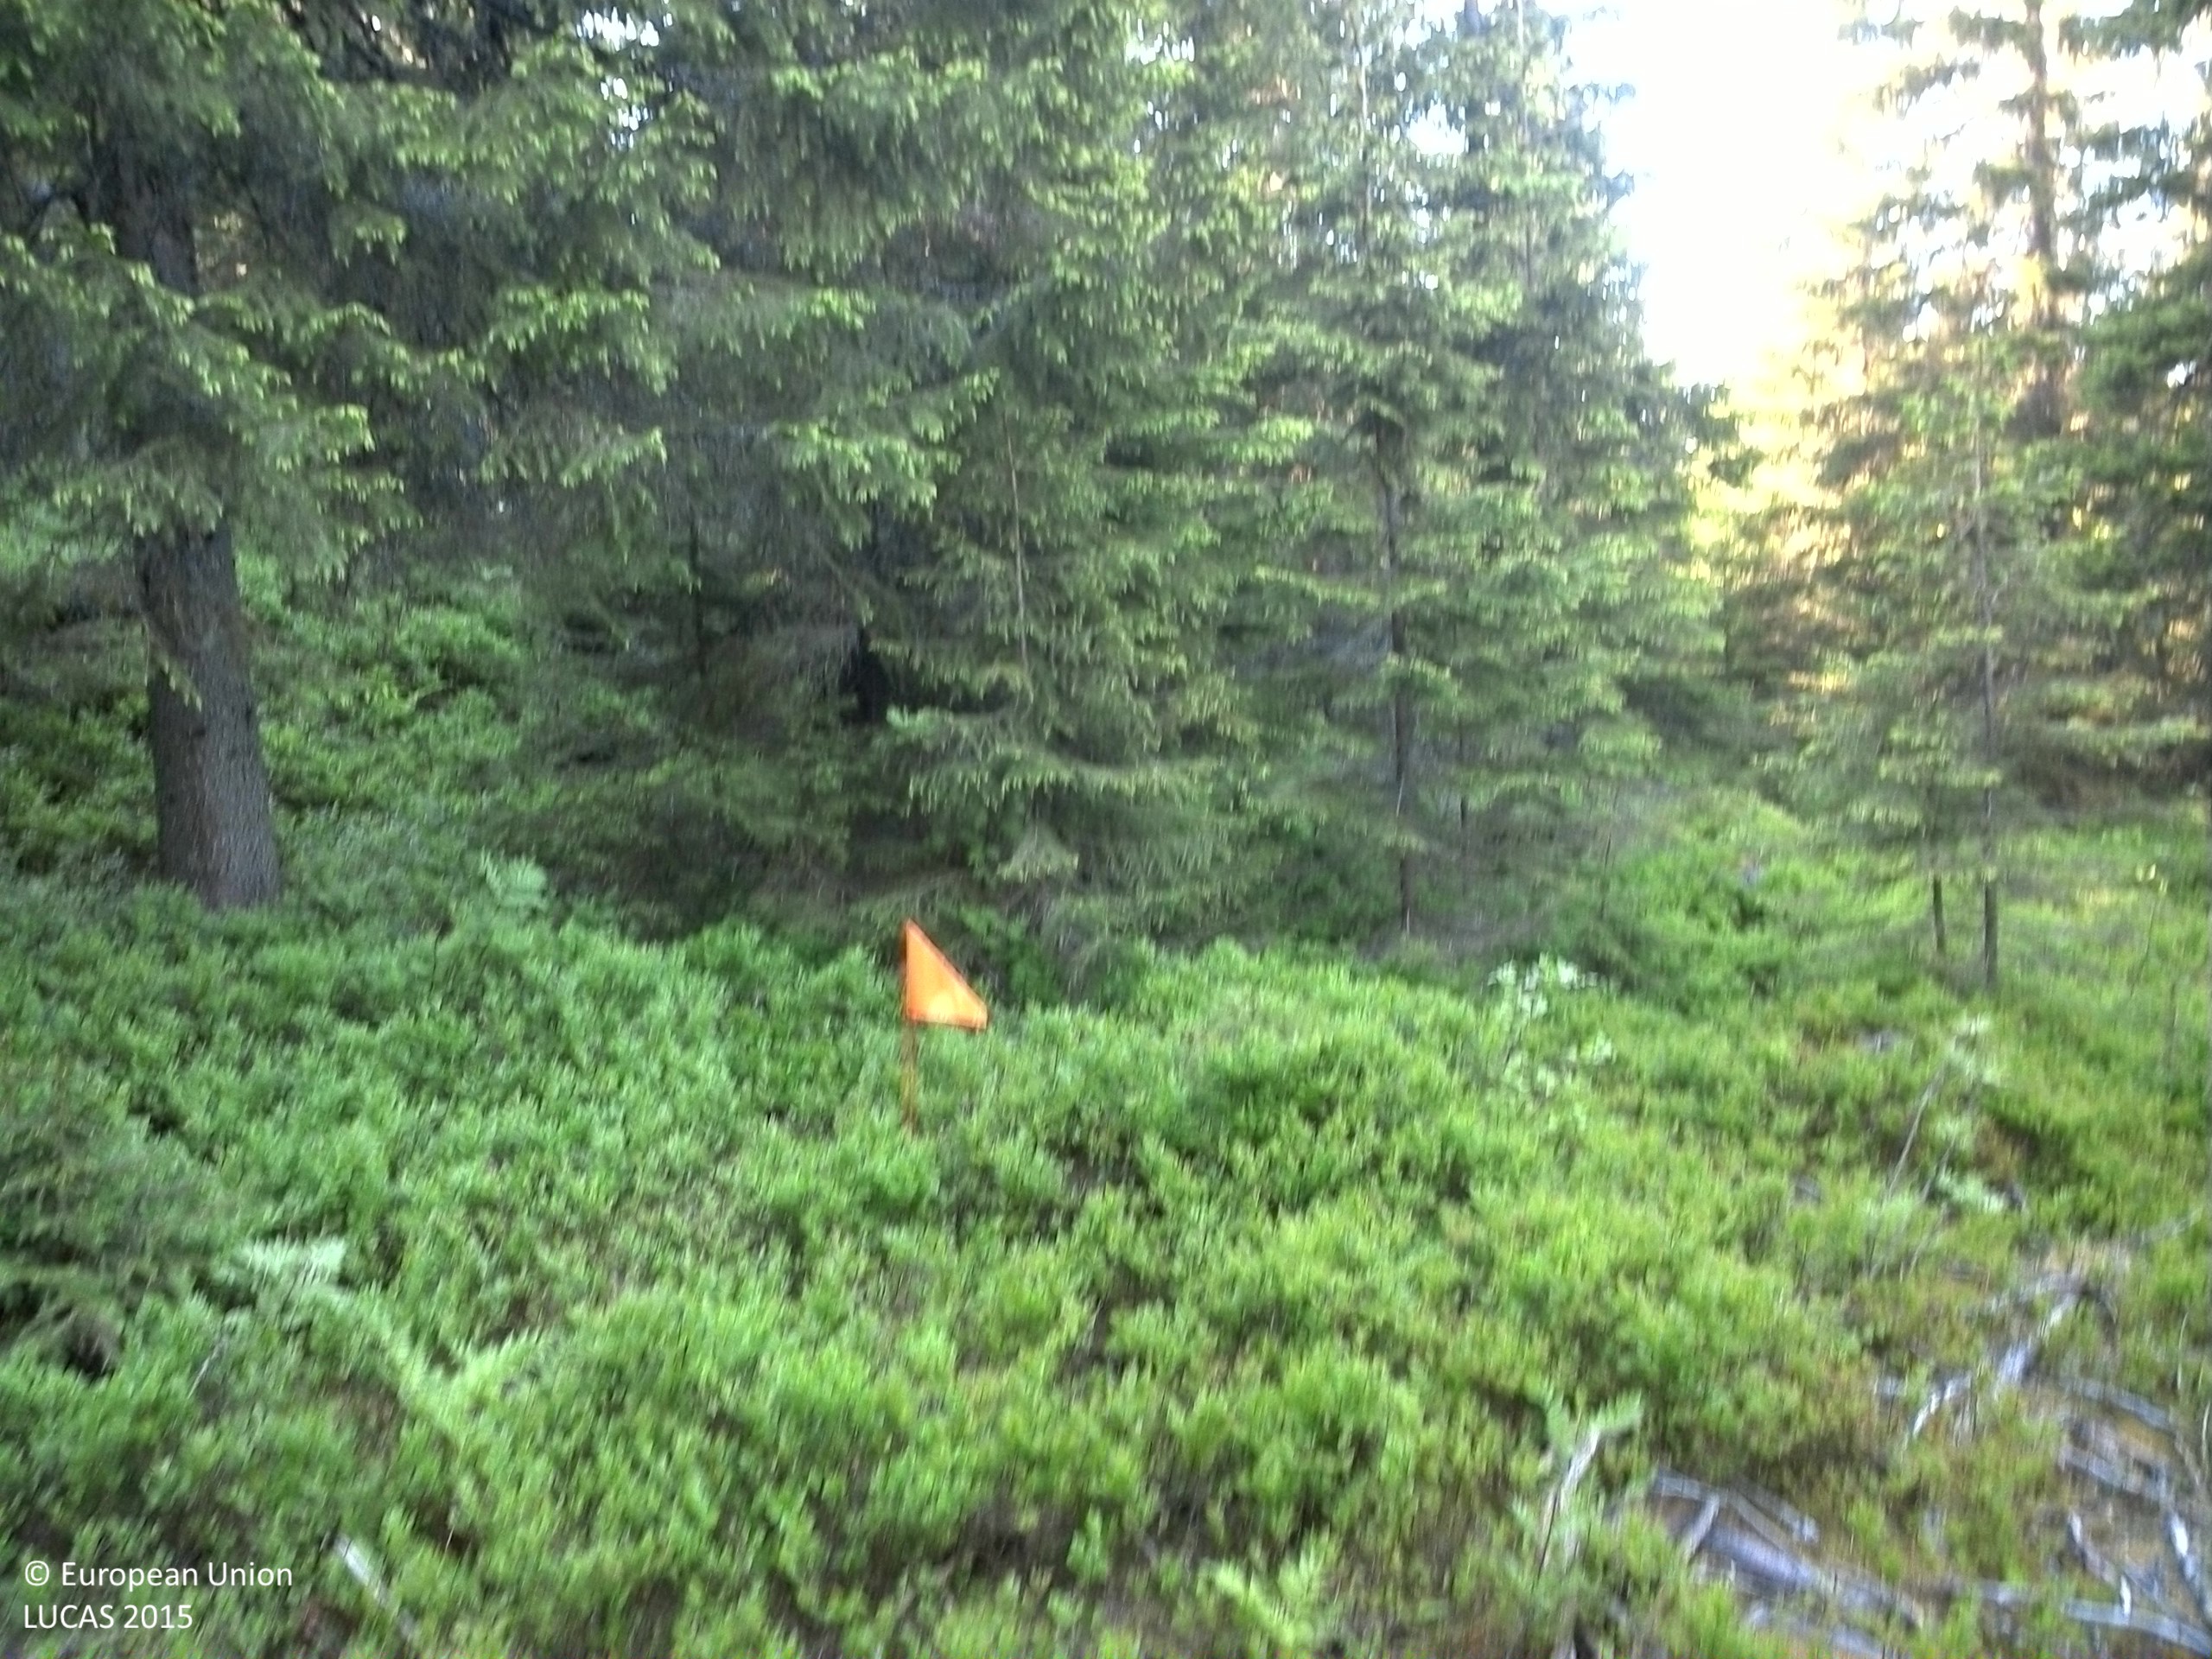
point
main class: Woodland
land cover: Spruce dominated coniferous woodland
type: boreal forest
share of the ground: 50 - 75 %
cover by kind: coniferous forest trees 60 %, shrubs 35 %, broadleaved forest trees 5 %
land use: Forestry
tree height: > 5 m
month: June
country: SE
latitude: 62.7570
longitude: 17.7528
